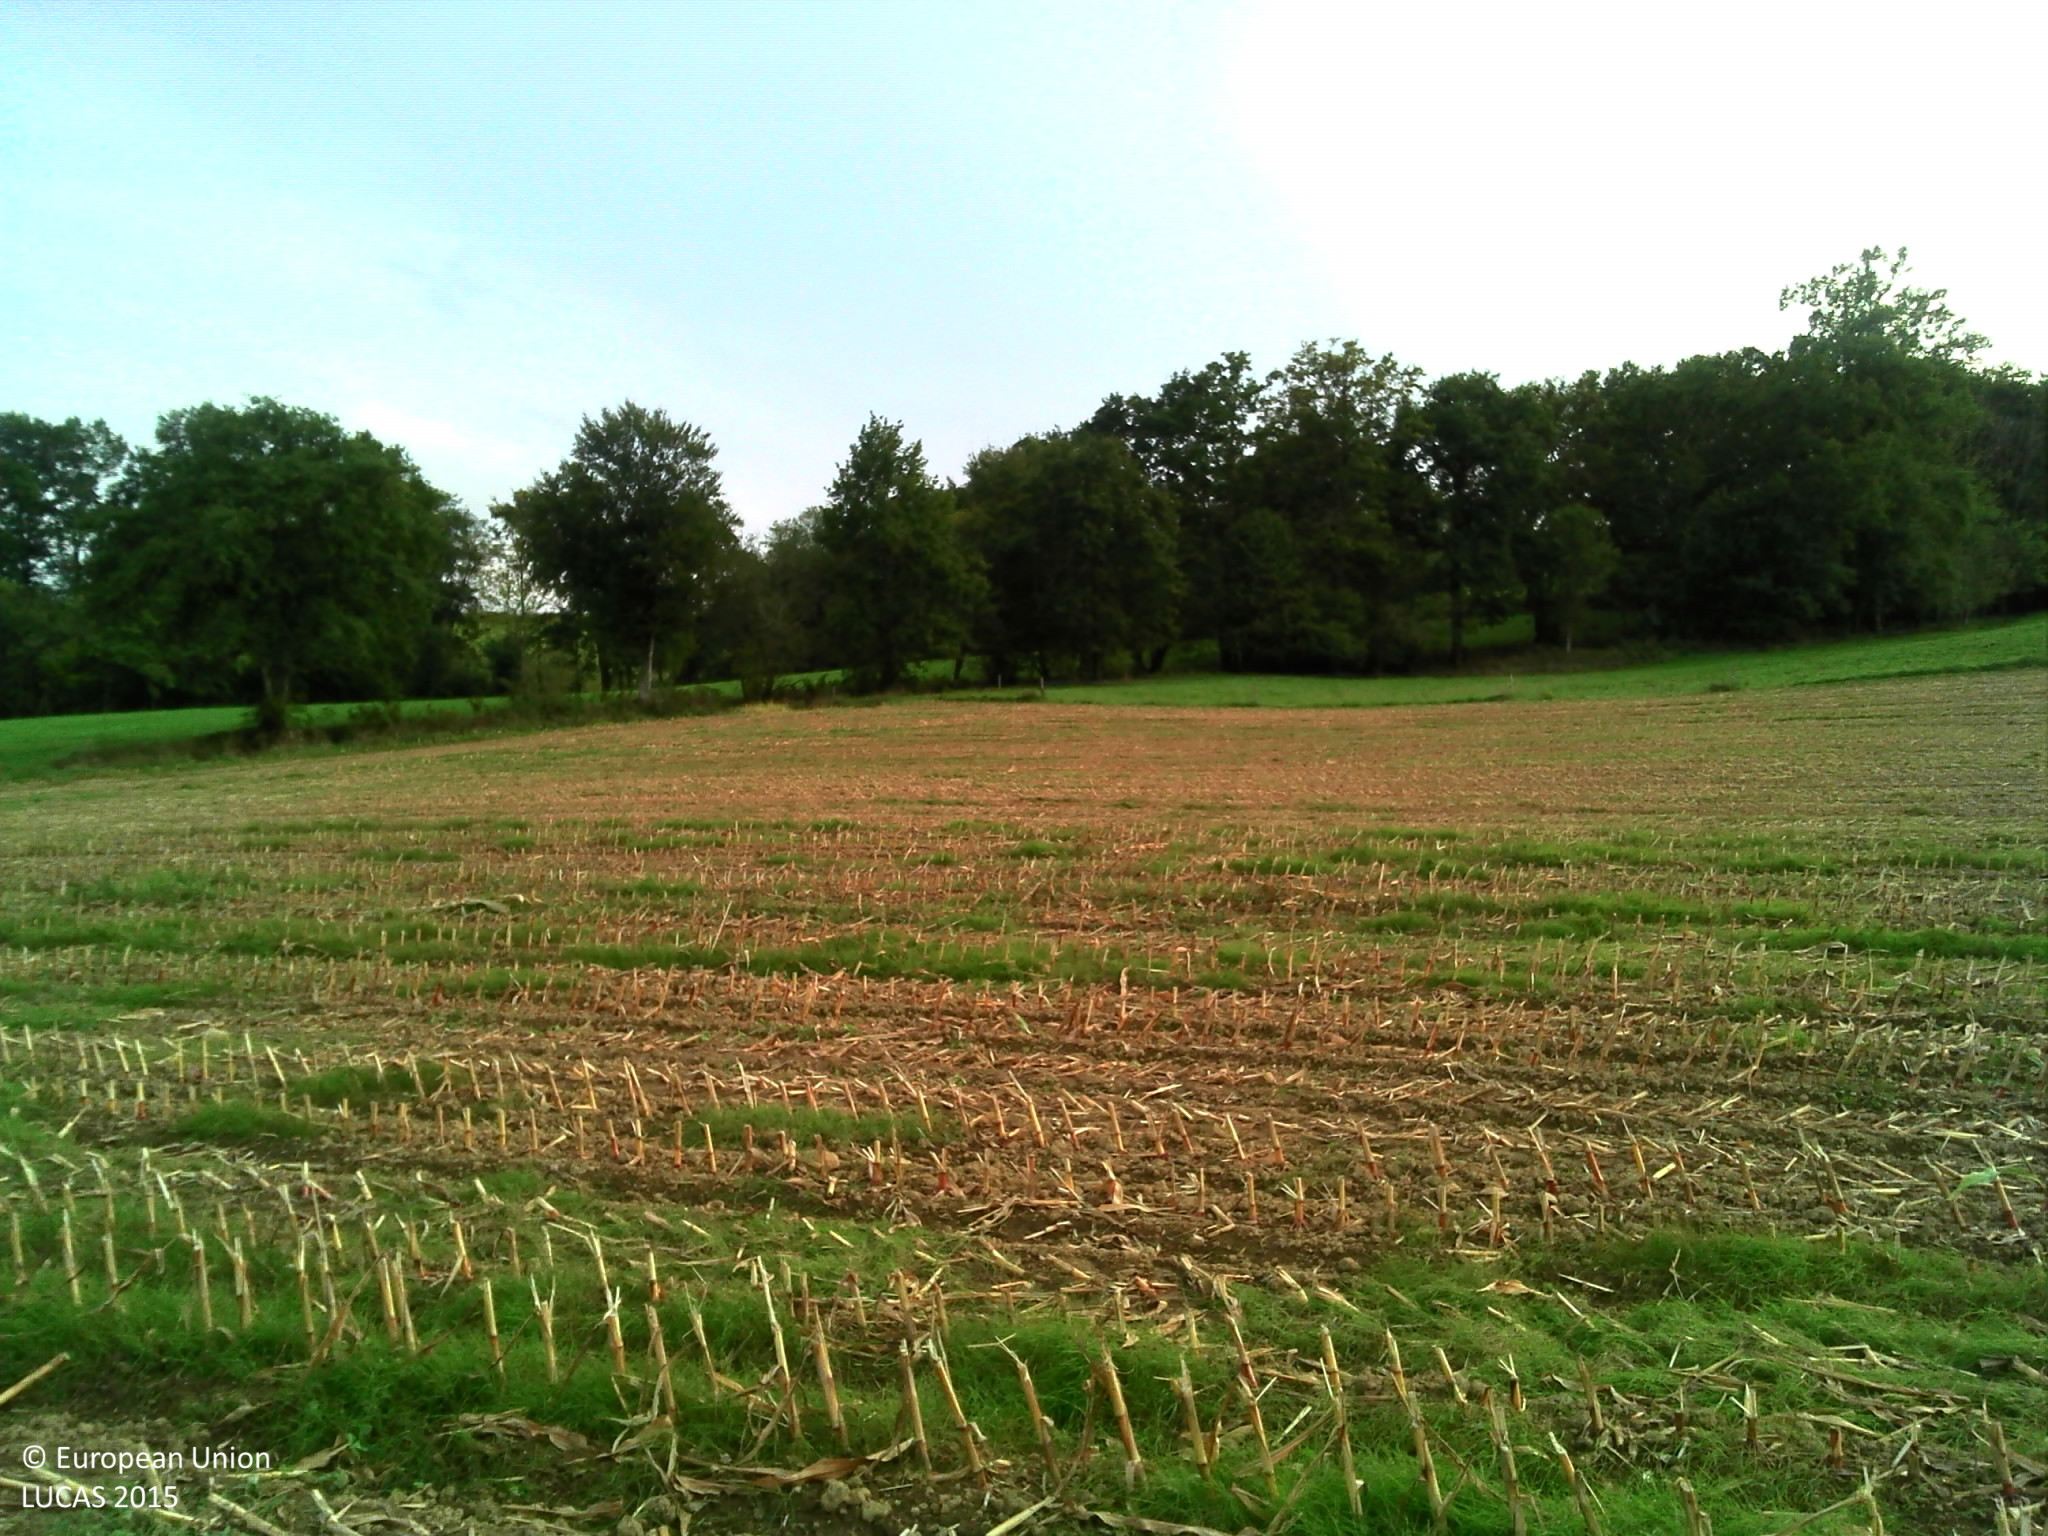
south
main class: Cropland
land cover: Maize
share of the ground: 10 - 25 %
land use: Agriculture (excluding fallow land and kitchen gardens)
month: September
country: FR
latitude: 43.2257
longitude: -0.4101
